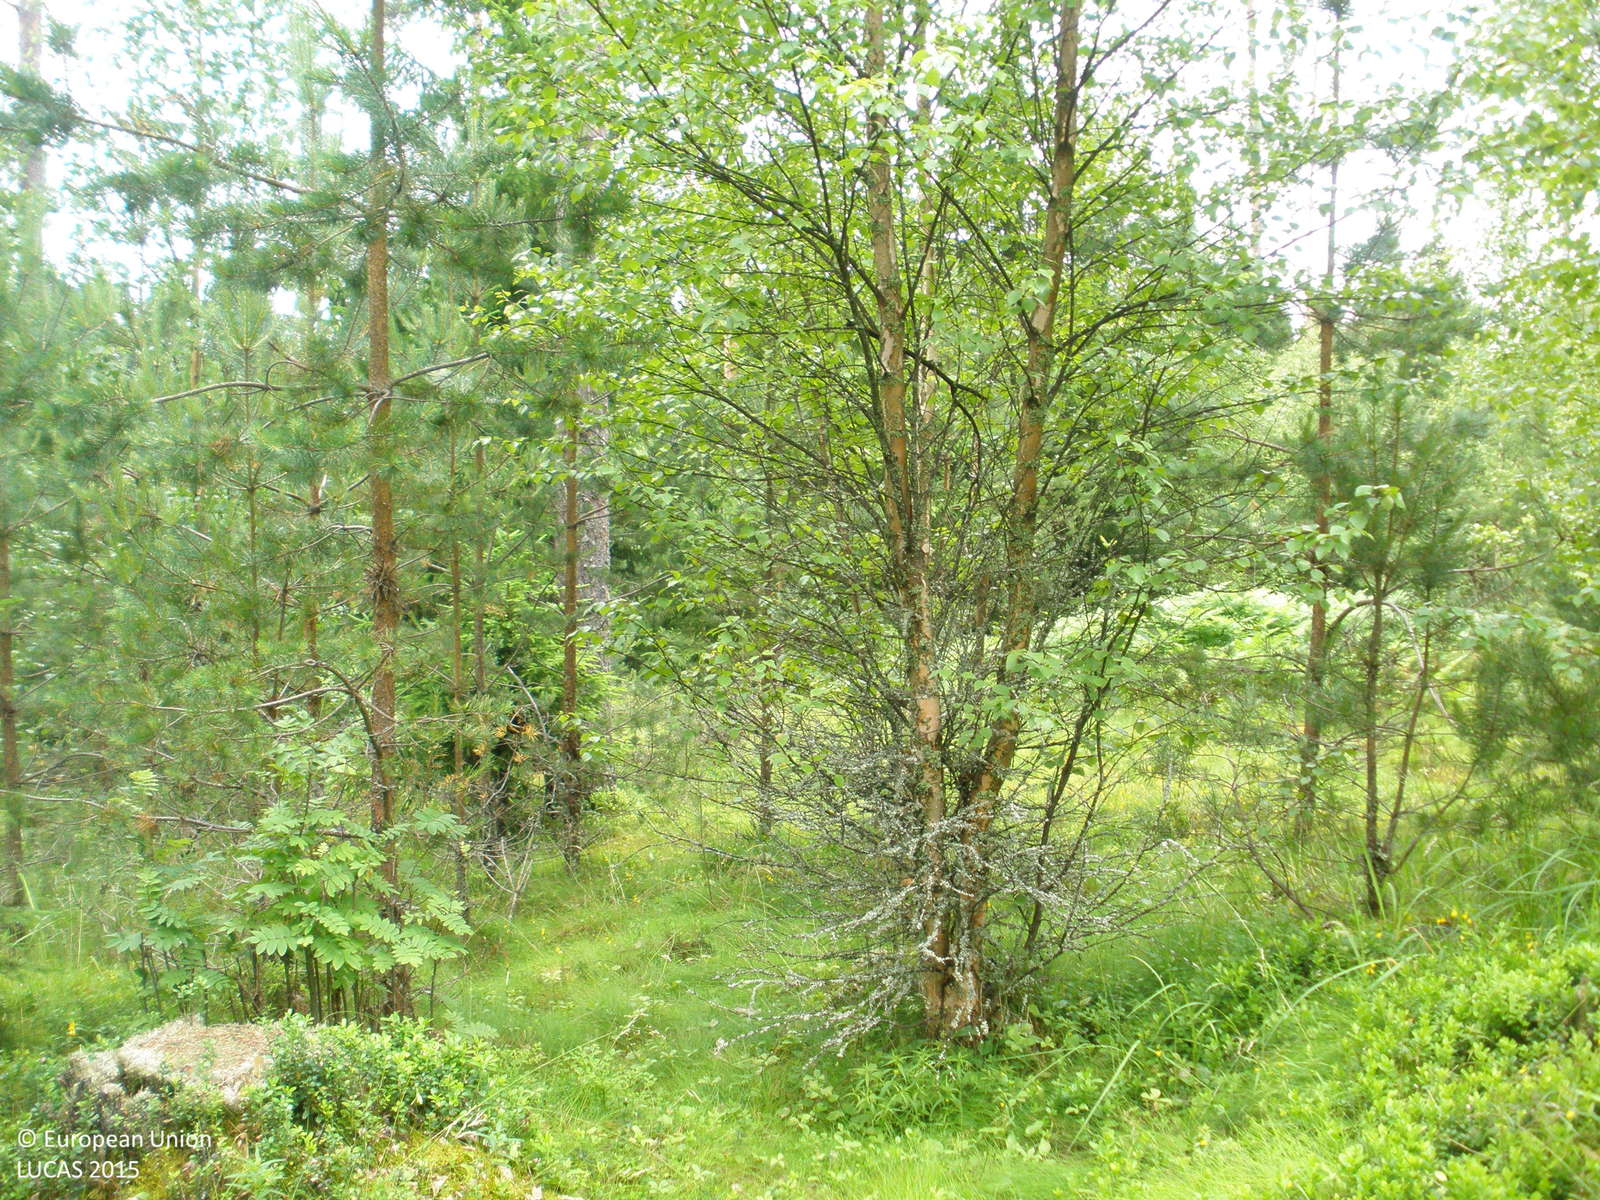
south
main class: Woodland
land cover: Other mixed woodland
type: boreal forest
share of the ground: 25 - 50 %
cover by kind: herbaceous plants 35 %, broadleaved forest trees 25 %, coniferous forest trees 20 %, shrubs 10 %, lichens and mosses 10 %
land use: Forestry
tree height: > 5 m
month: July
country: FI
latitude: 61.3603
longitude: 23.6808
